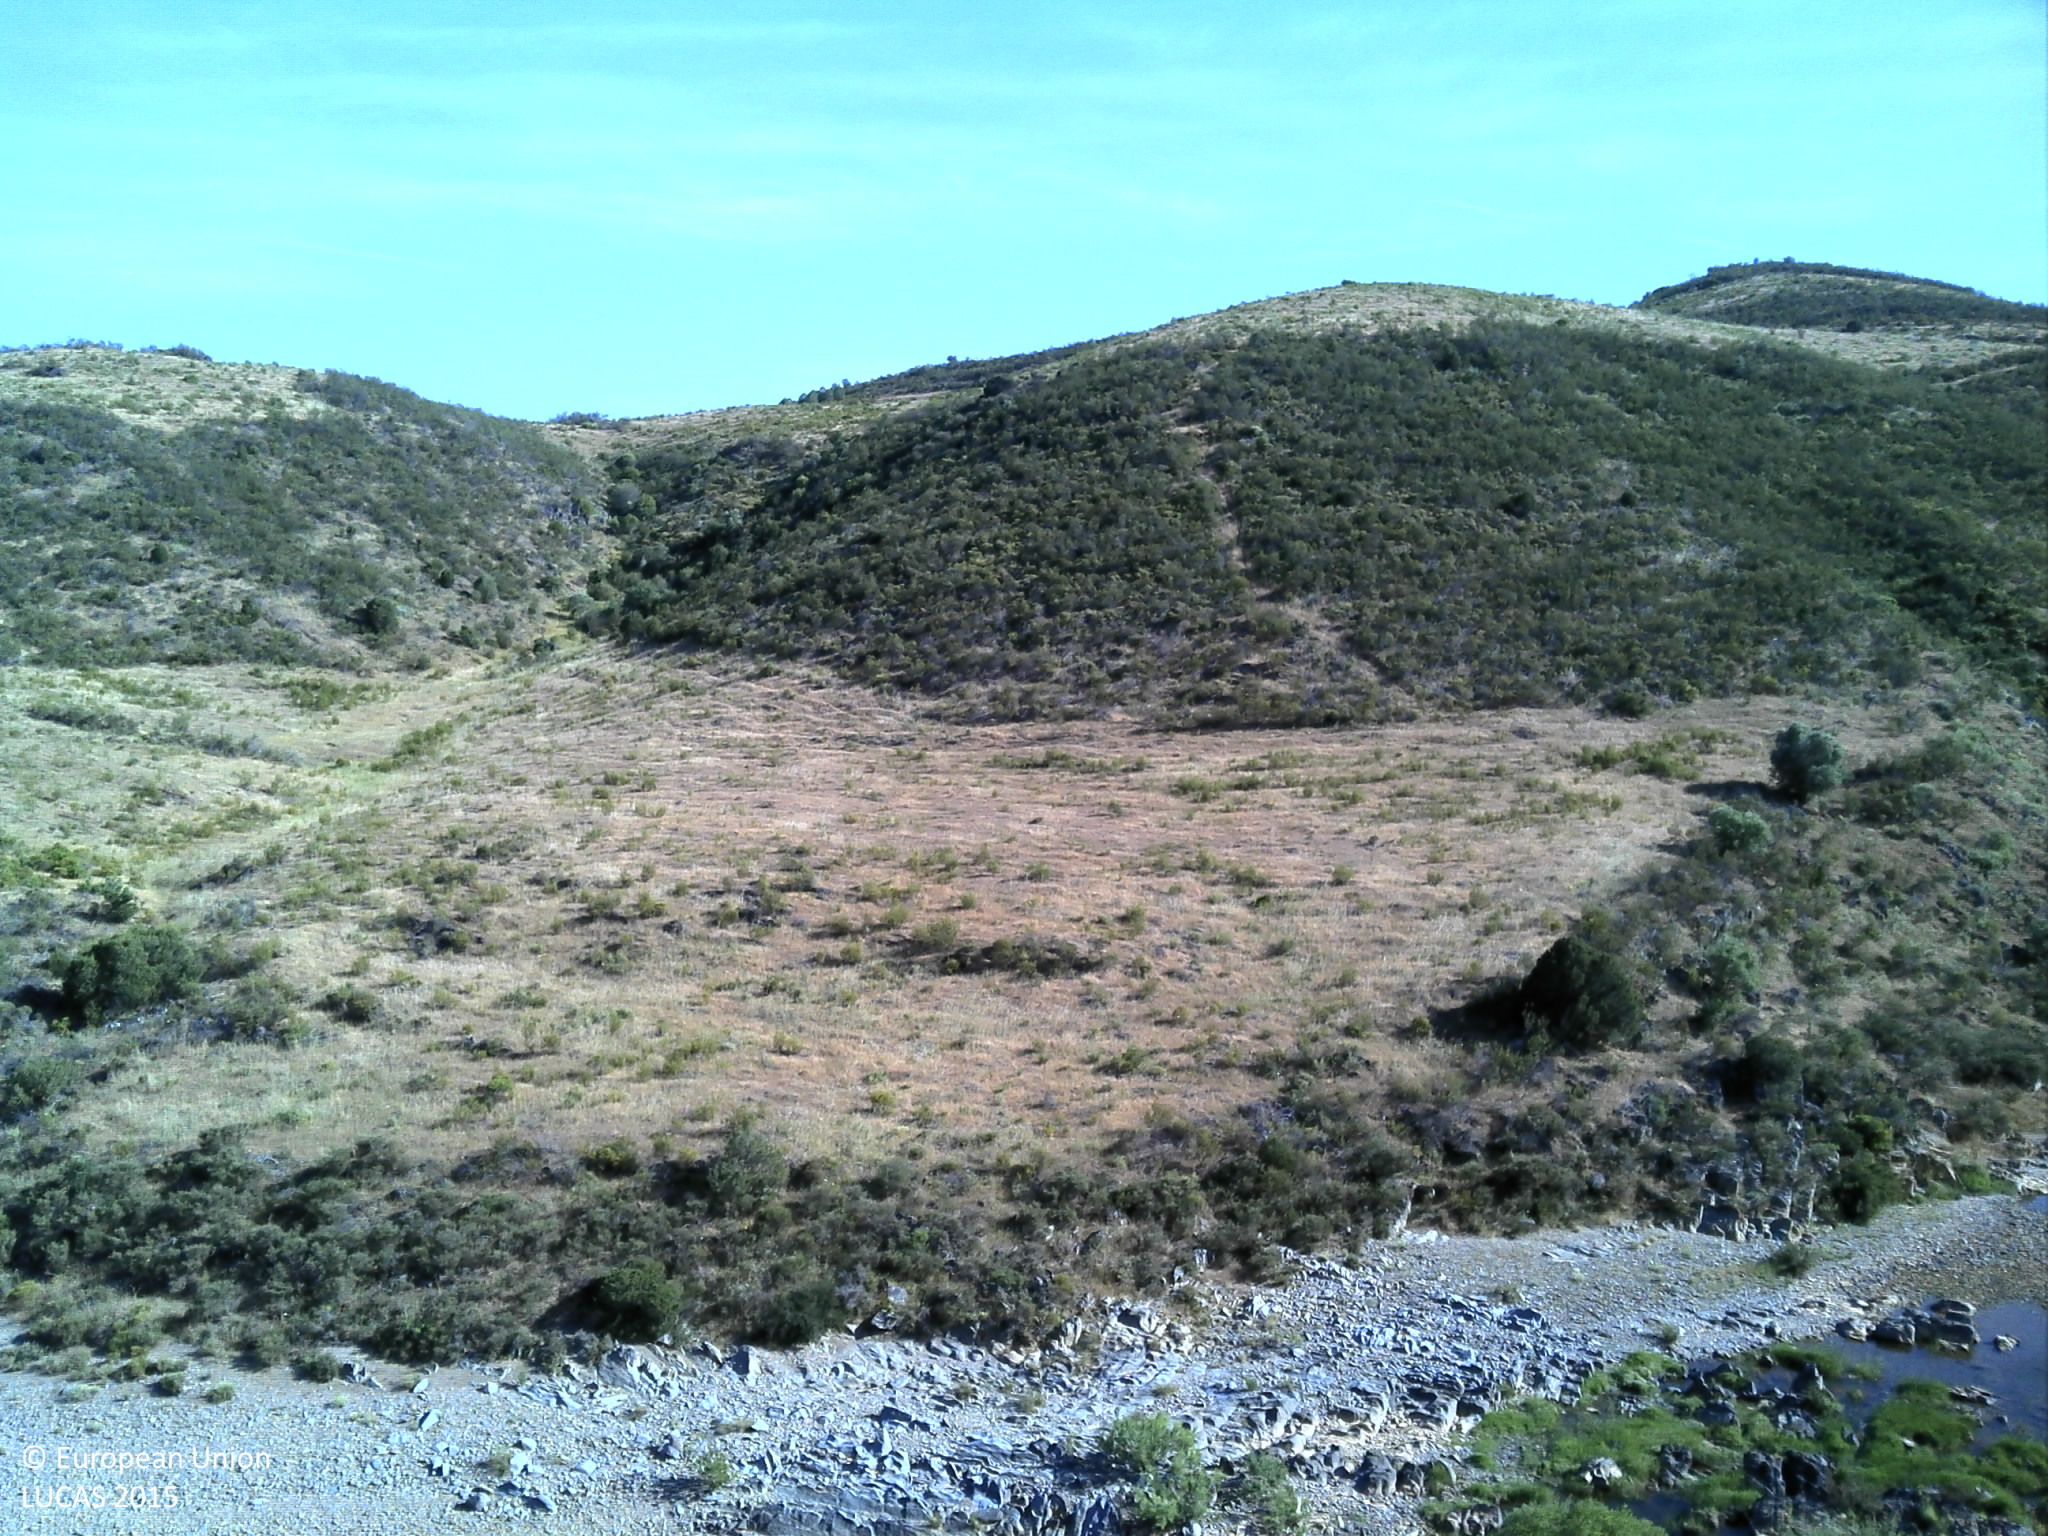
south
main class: Shrubland
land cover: Shrubland without tree cover
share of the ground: > 75 %
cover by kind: shrubs 95 %, unconsolidated bare surface 5 %
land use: Semi-natural and natural areas not in use
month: May
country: PT
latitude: 37.5237
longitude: -7.5608
